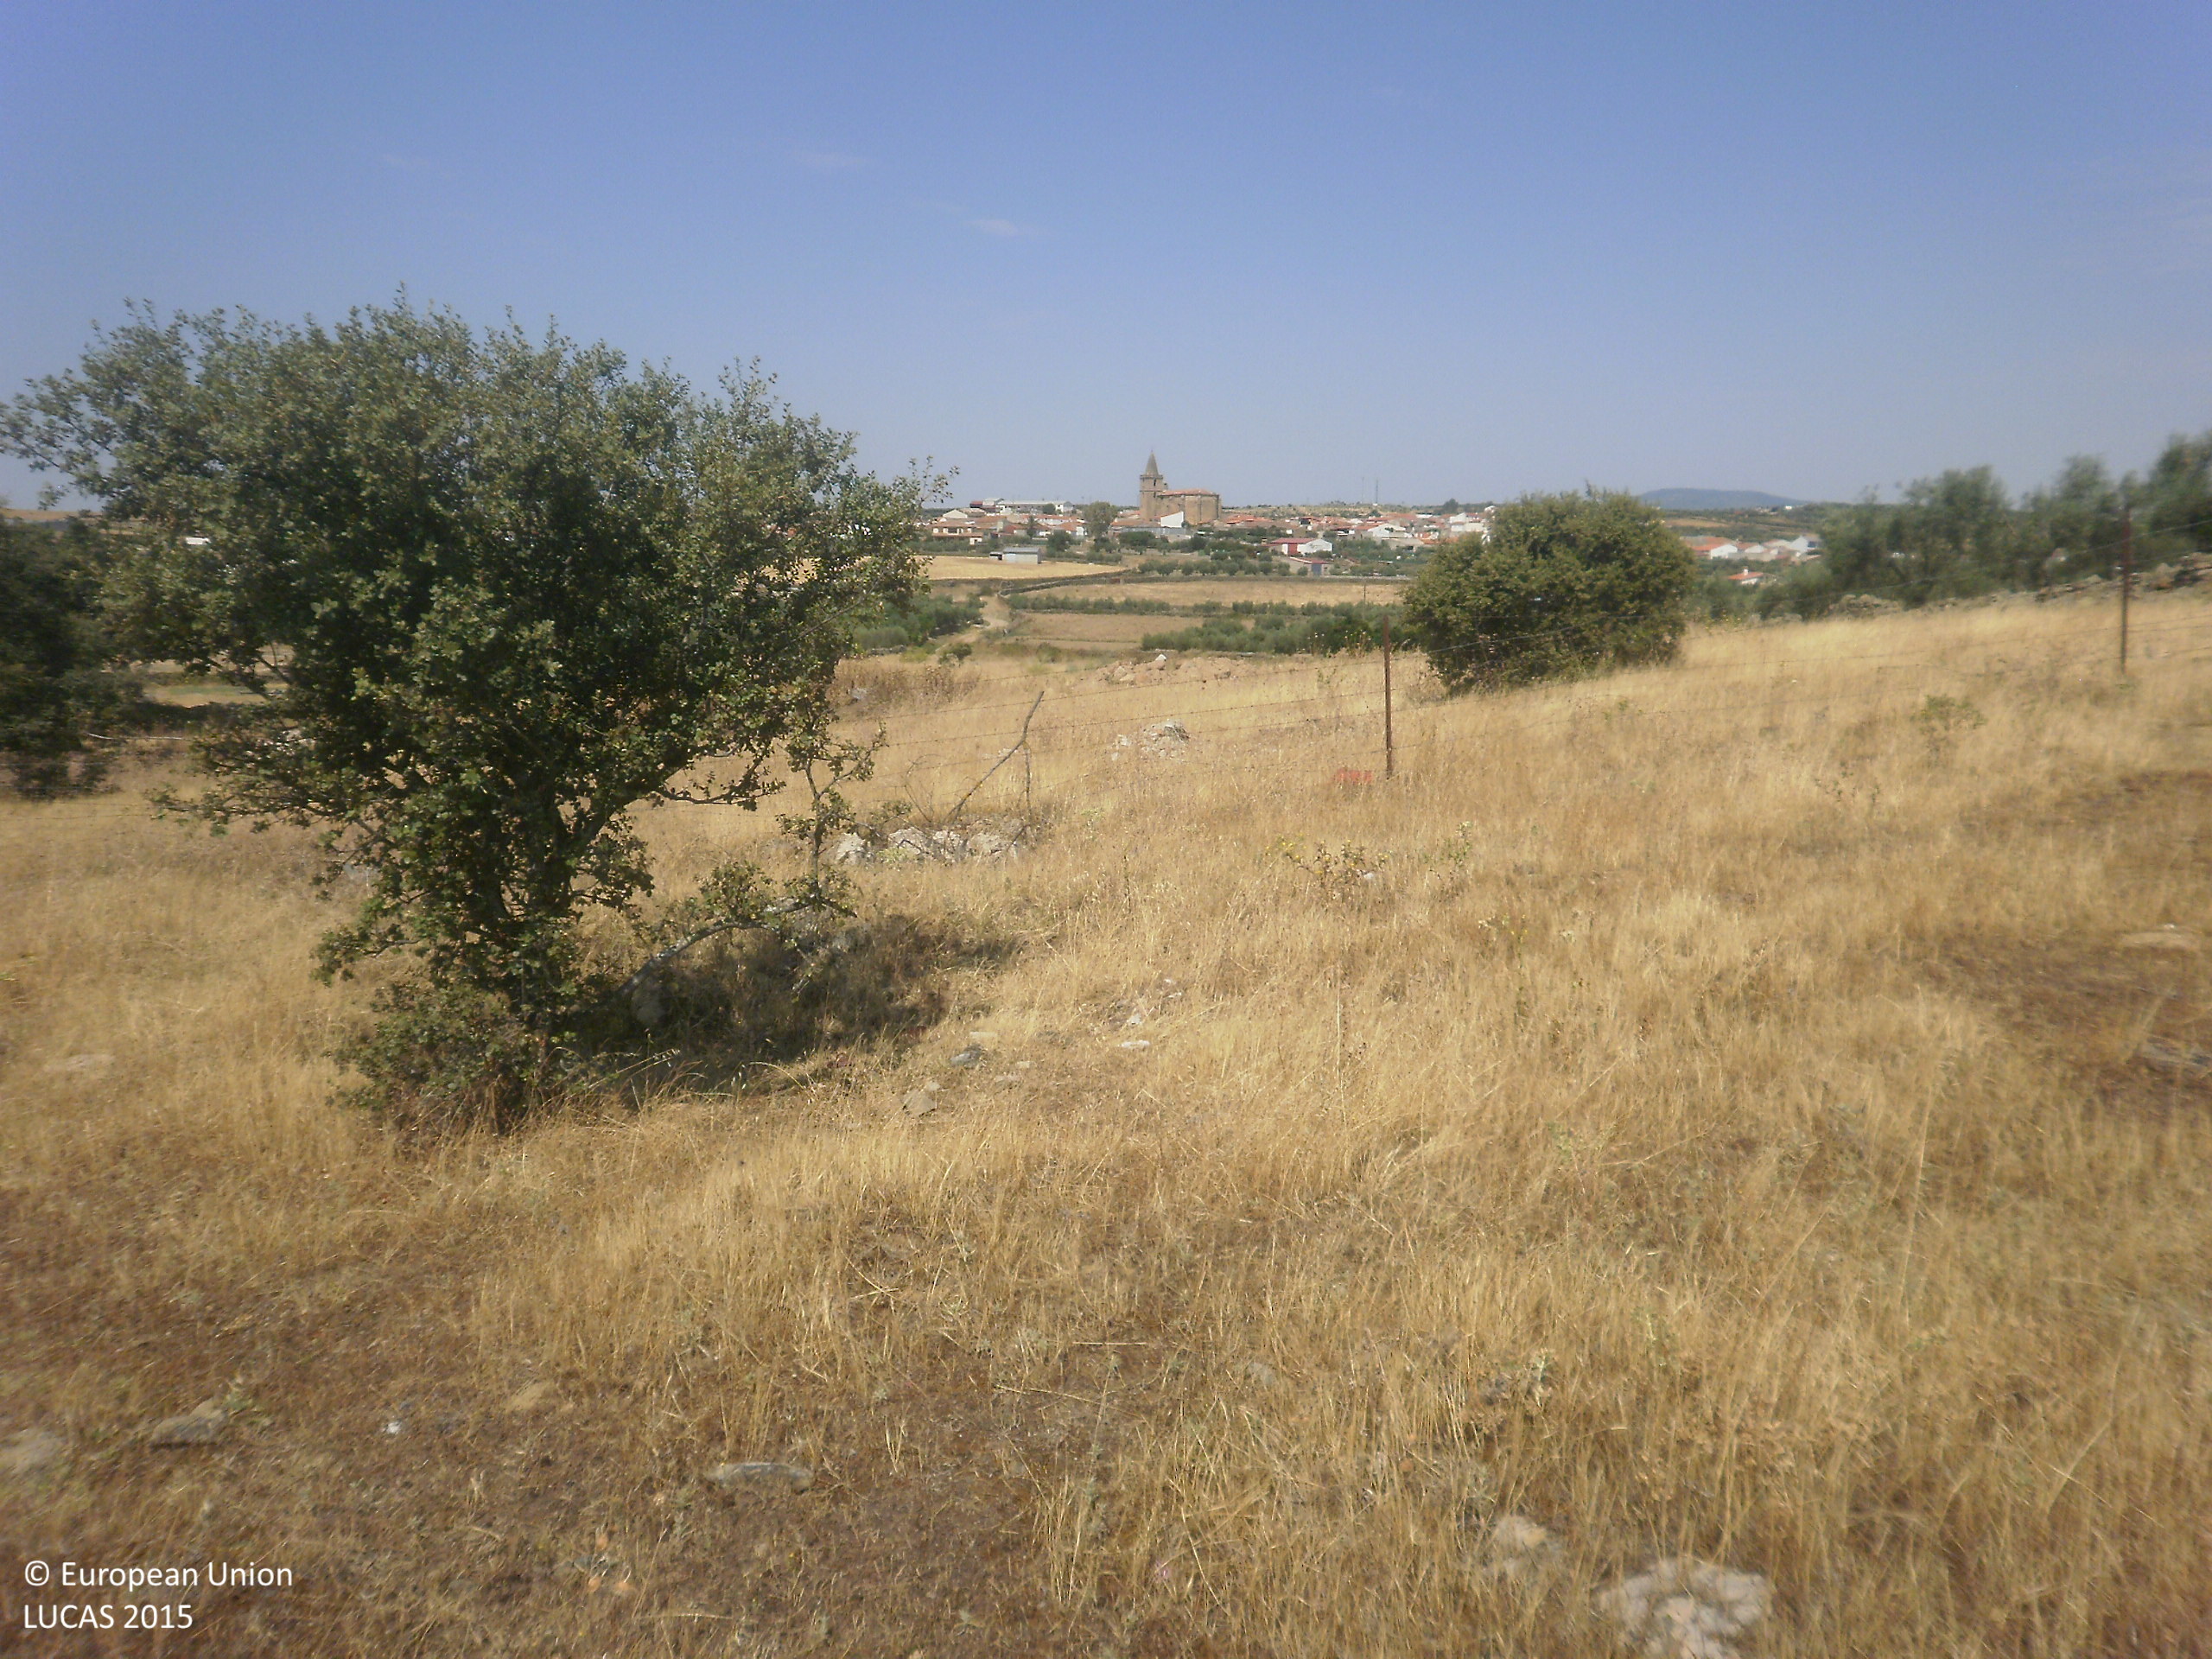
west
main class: Grassland
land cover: Grassland with sparse tree/shrub cover
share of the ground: > 75 %
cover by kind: herbaceous plants 90 %, broadleaved forest trees 5 %, shrubs 5 %
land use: Agriculture (excluding fallow land and kitchen gardens)
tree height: > 5 m
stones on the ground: < 10 %
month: June
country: ES
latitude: 39.1679
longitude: -5.8750
